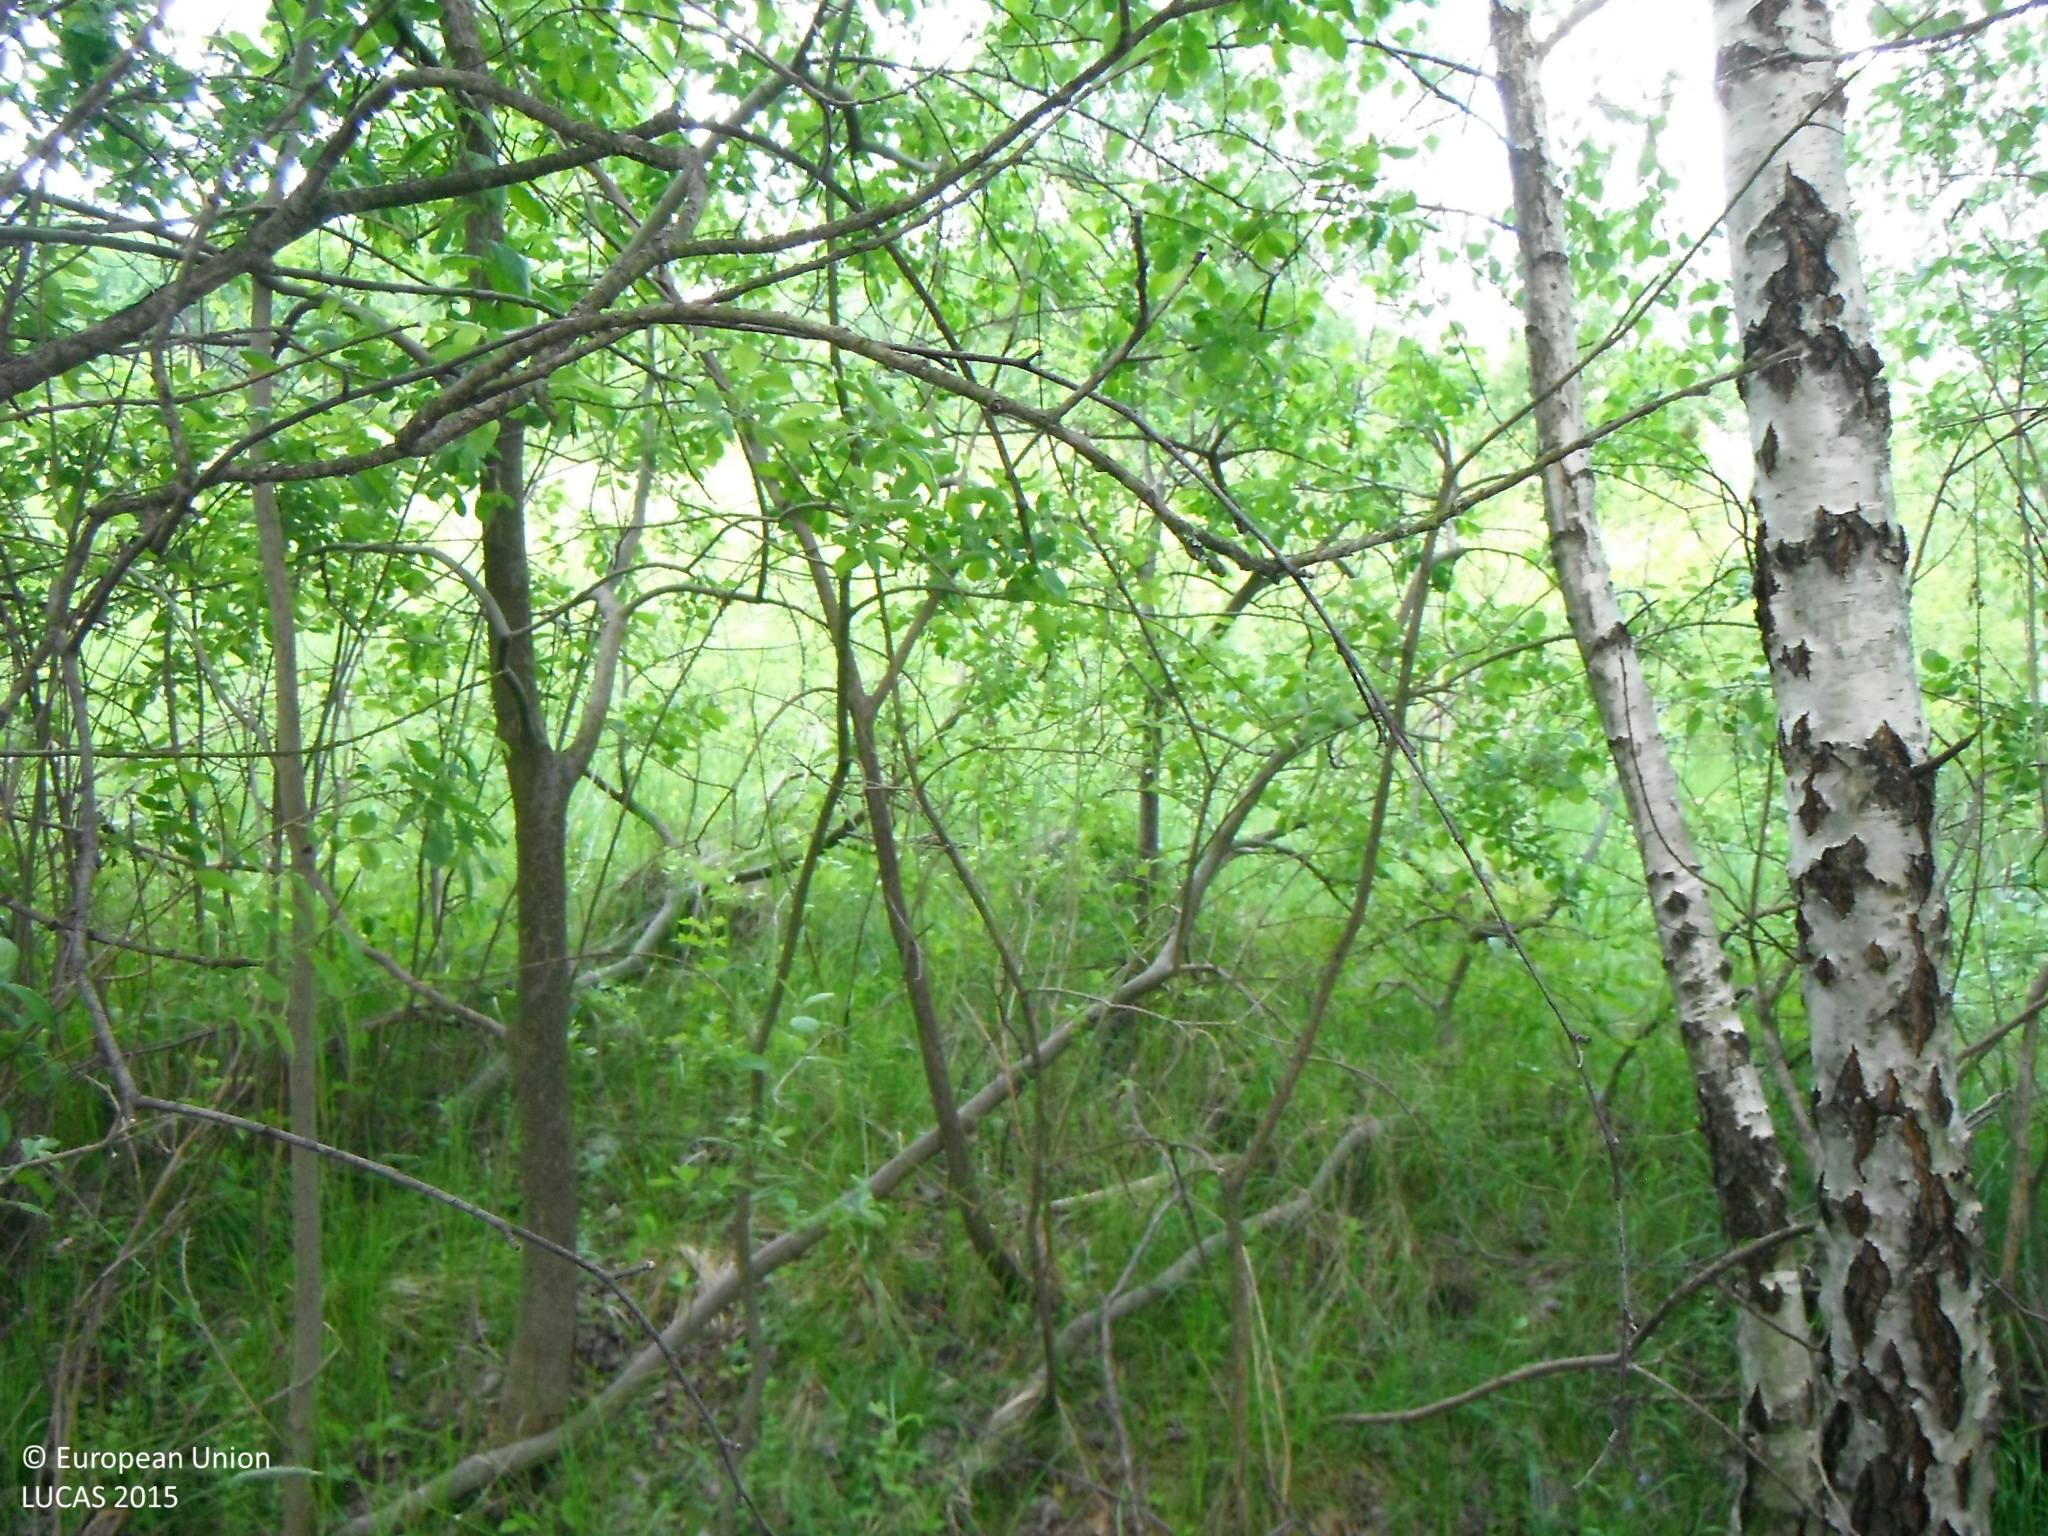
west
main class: Woodland
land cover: Broadleaved woodland
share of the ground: > 75 %
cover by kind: broadleaved forest trees 85 %, herbaceous plants 10 %, shrubs 5 %
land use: Forestry
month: June
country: SK
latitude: 48.4912
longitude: 19.4012
